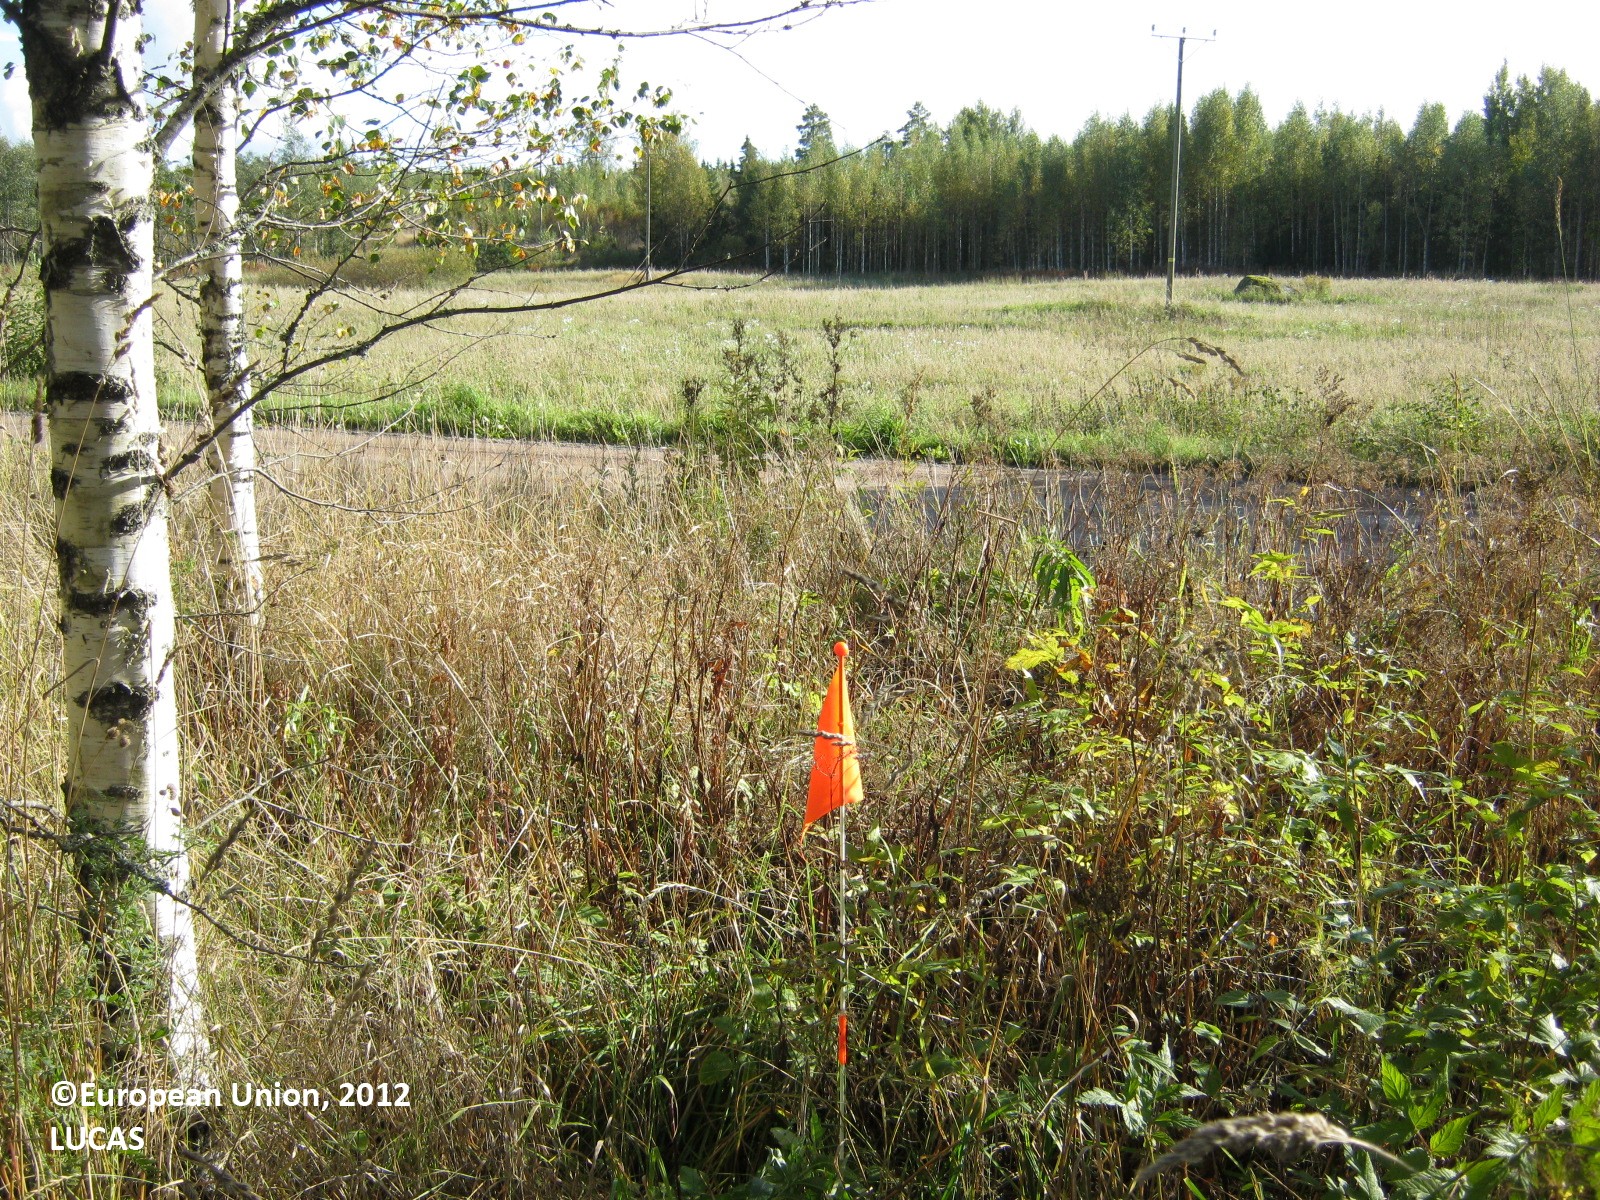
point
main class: Woodland
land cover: Broadleaved woodland
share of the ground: > 75 %
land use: Forestry
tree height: > 5 m
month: September
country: FI
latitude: 60.6665
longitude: 27.9317
